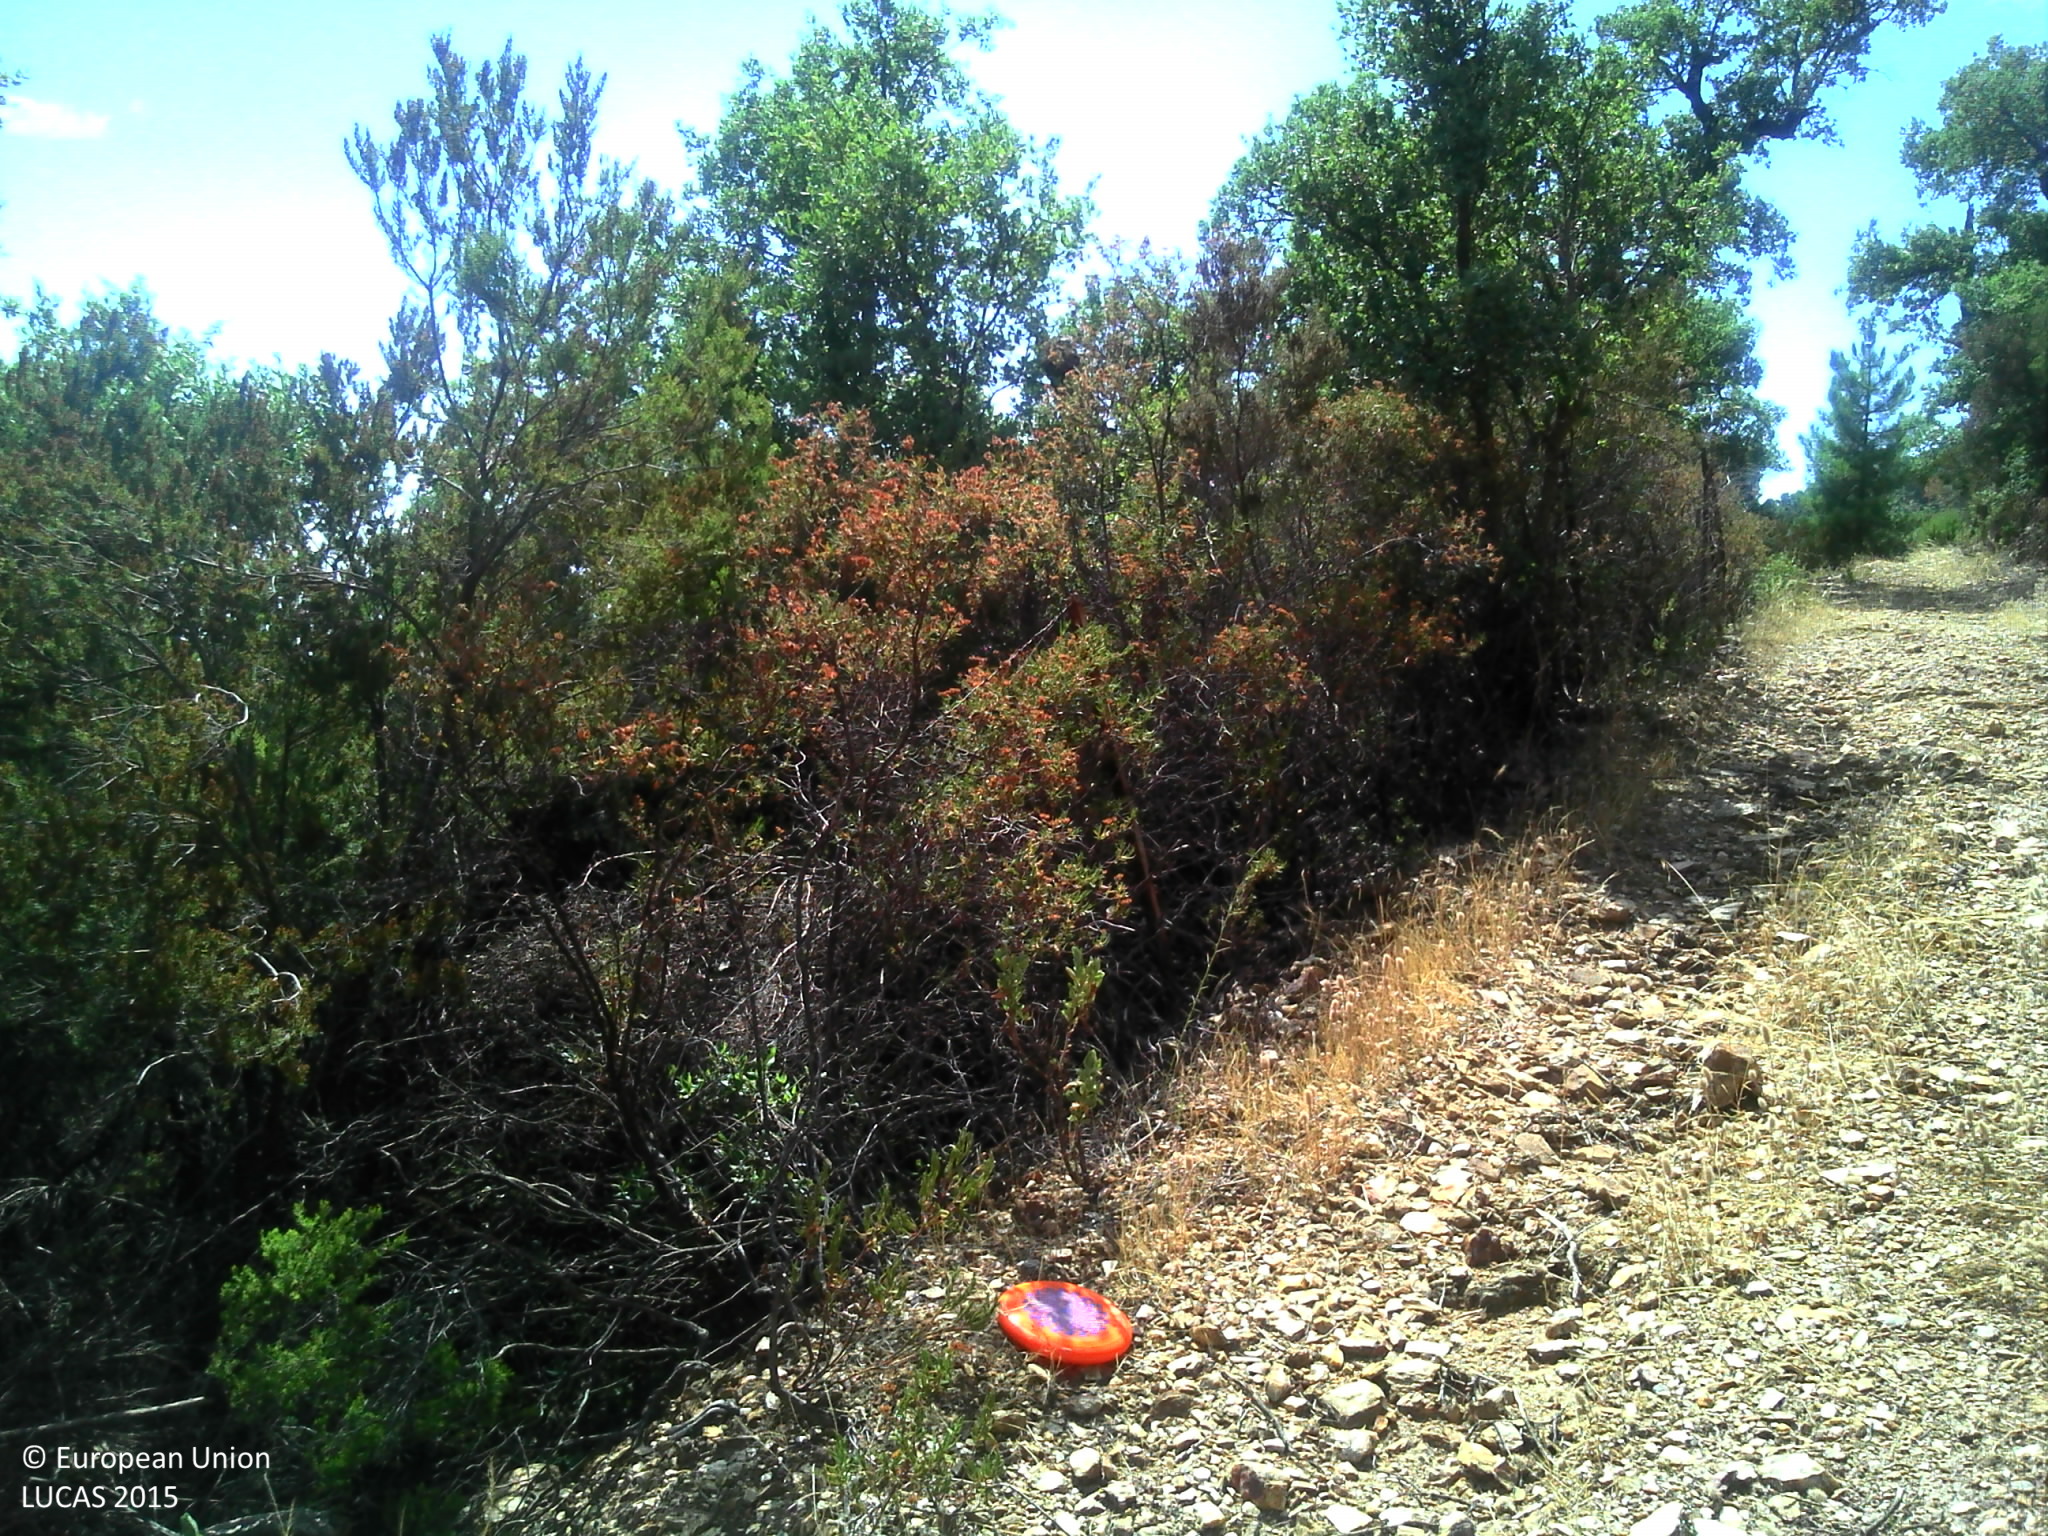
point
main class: Shrubland
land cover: Shrubland with sparse tree cover
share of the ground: > 75 %
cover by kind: shrubs 95 %, broadleaved forest trees 5 %
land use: Semi-natural and natural areas not in use
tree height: > 5 m
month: July
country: FR
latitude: 43.2011
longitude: 6.3051
